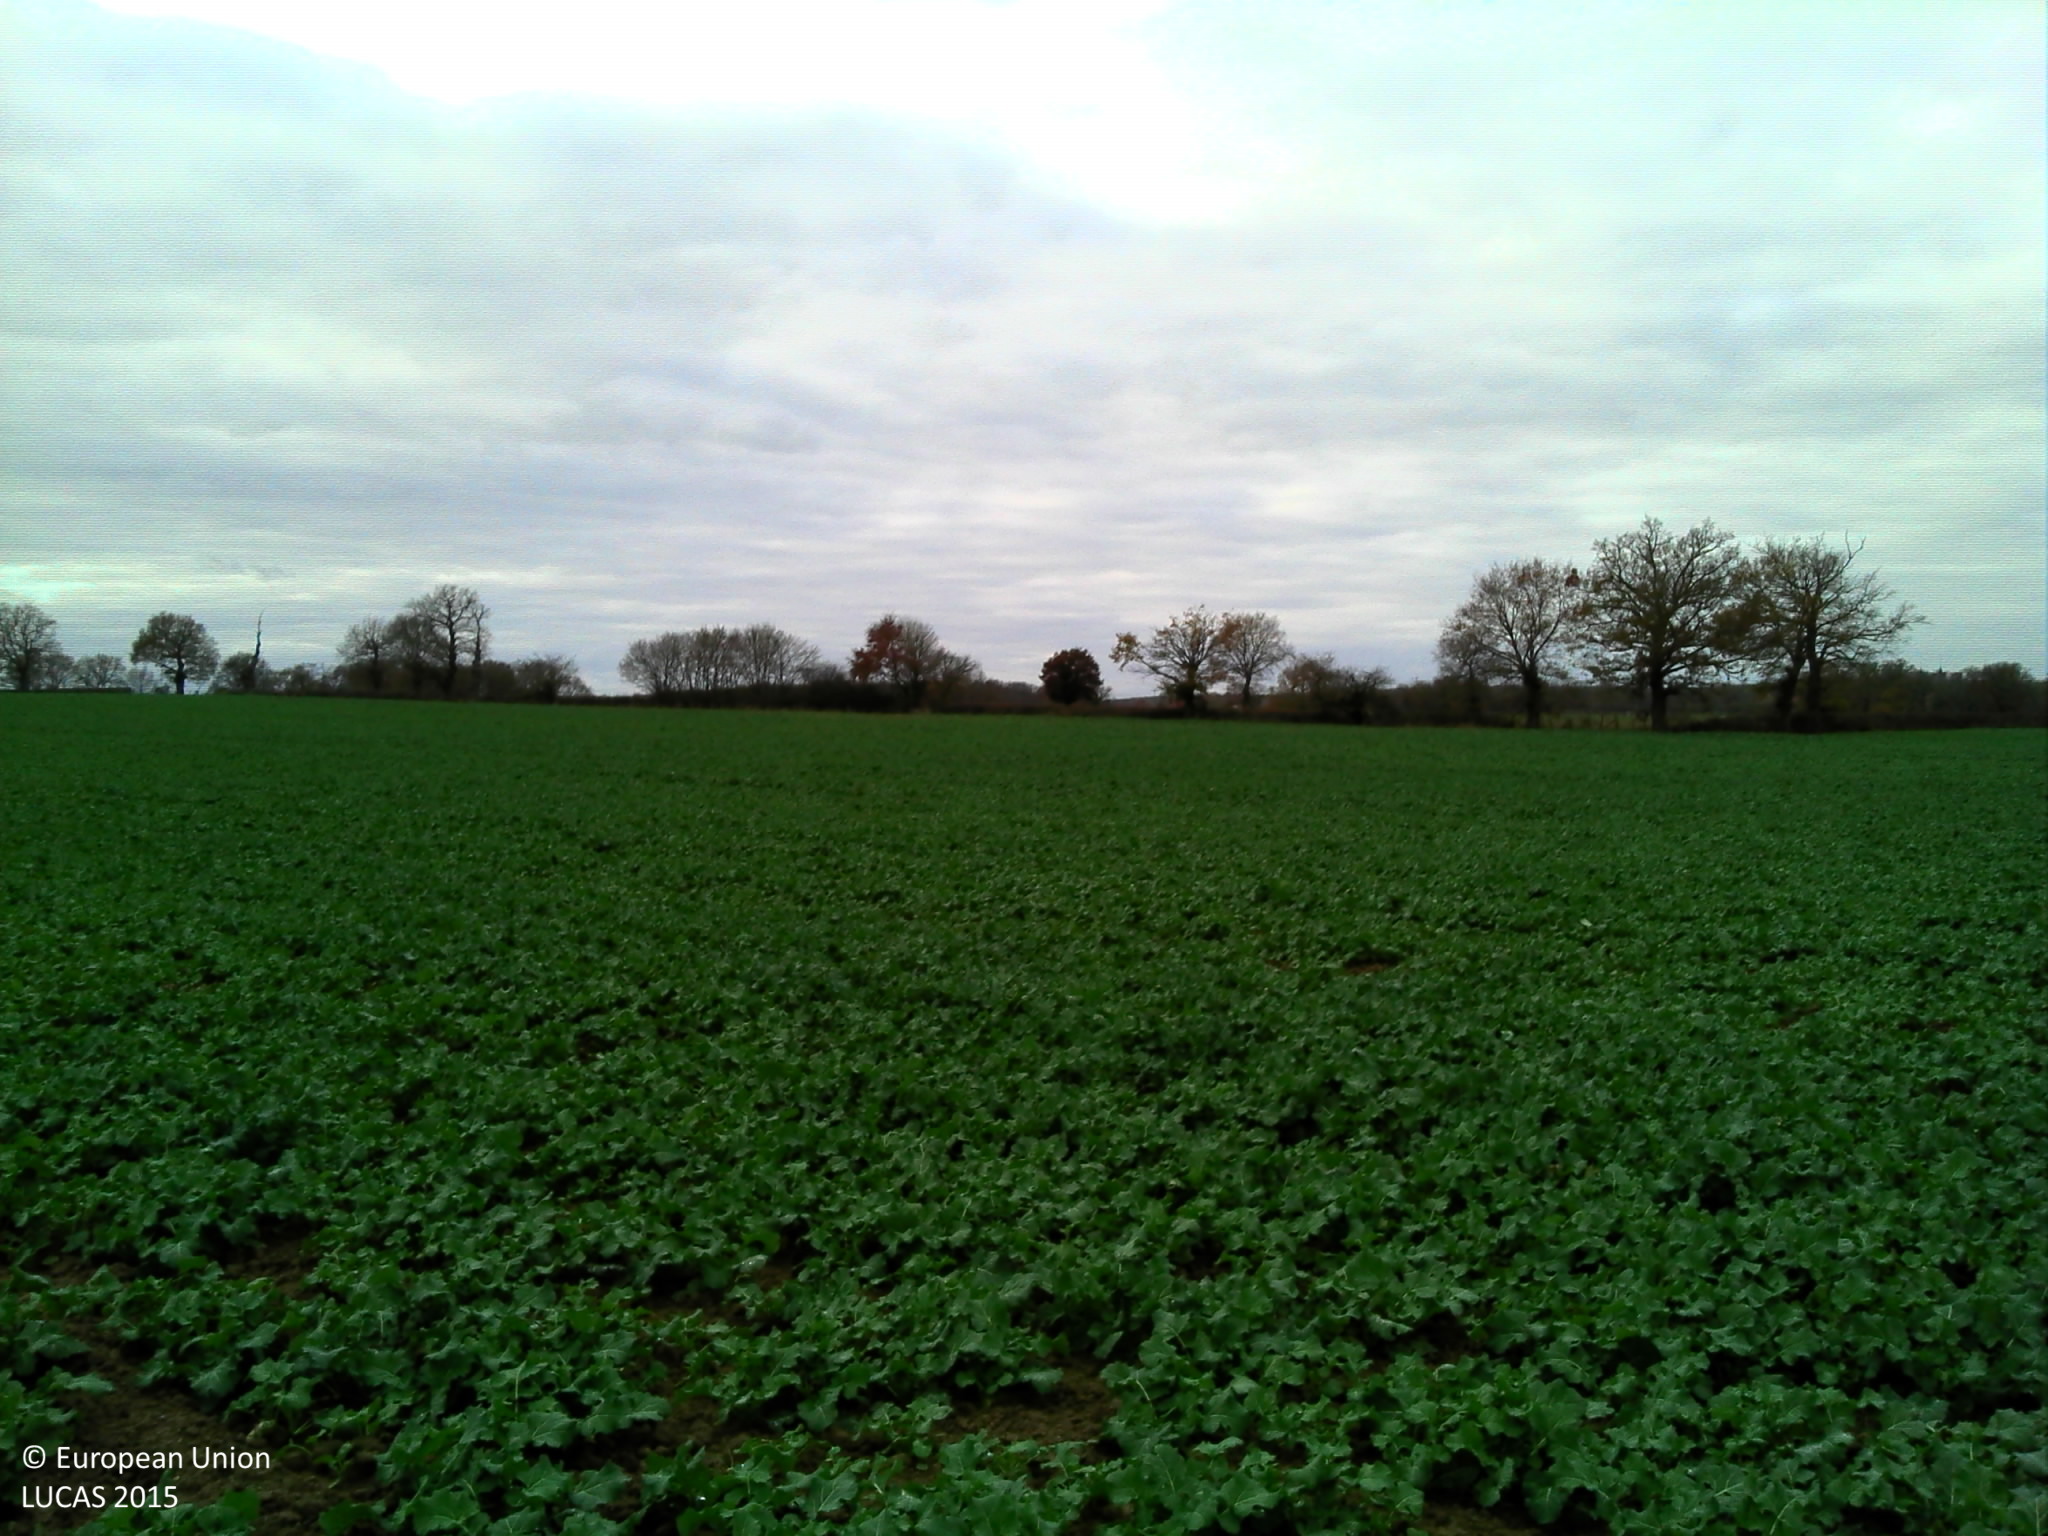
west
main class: Cropland
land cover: Rape and turnip rape
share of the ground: > 75 %
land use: Agriculture (excluding fallow land and kitchen gardens)
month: November
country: FR
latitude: 46.6255
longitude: 3.2455
